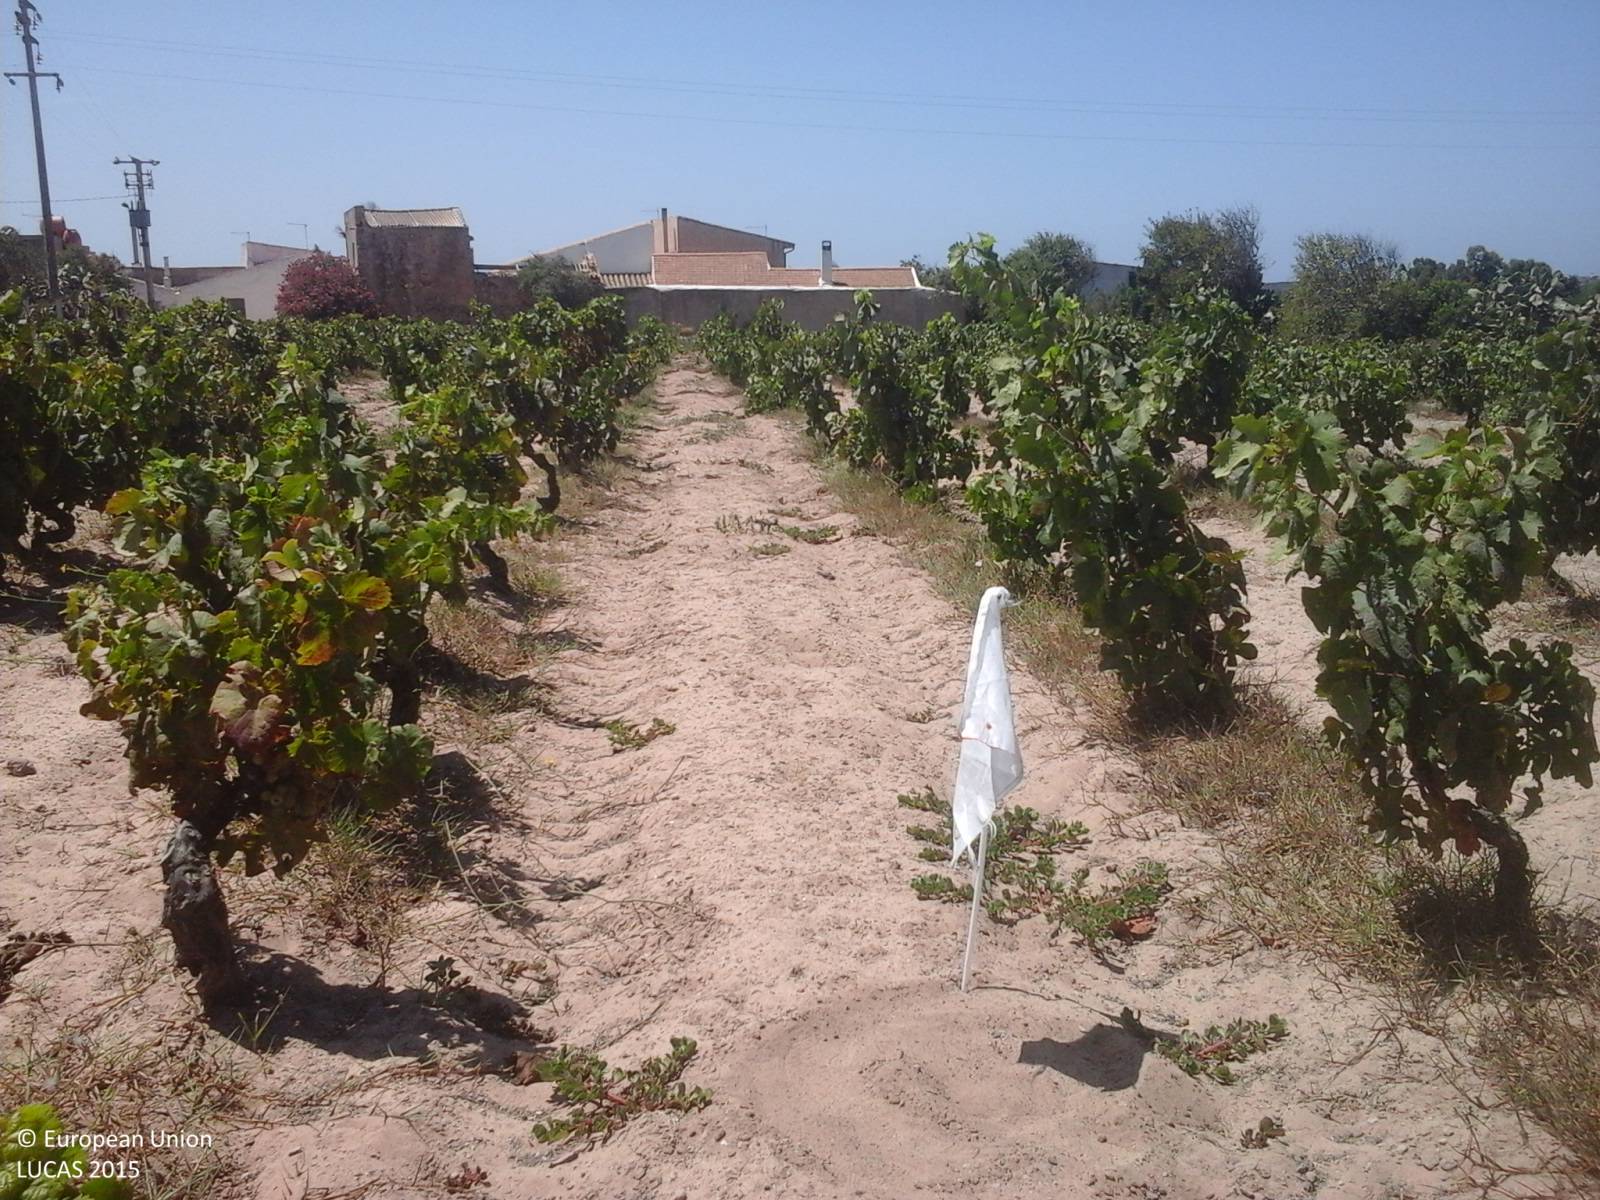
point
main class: Cropland
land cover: Vineyards
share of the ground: 50 - 75 %
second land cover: Other bare soil
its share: > 75 %
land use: Agriculture (excluding fallow land and kitchen gardens)
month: July
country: IT
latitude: 39.0949
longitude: 8.4029
